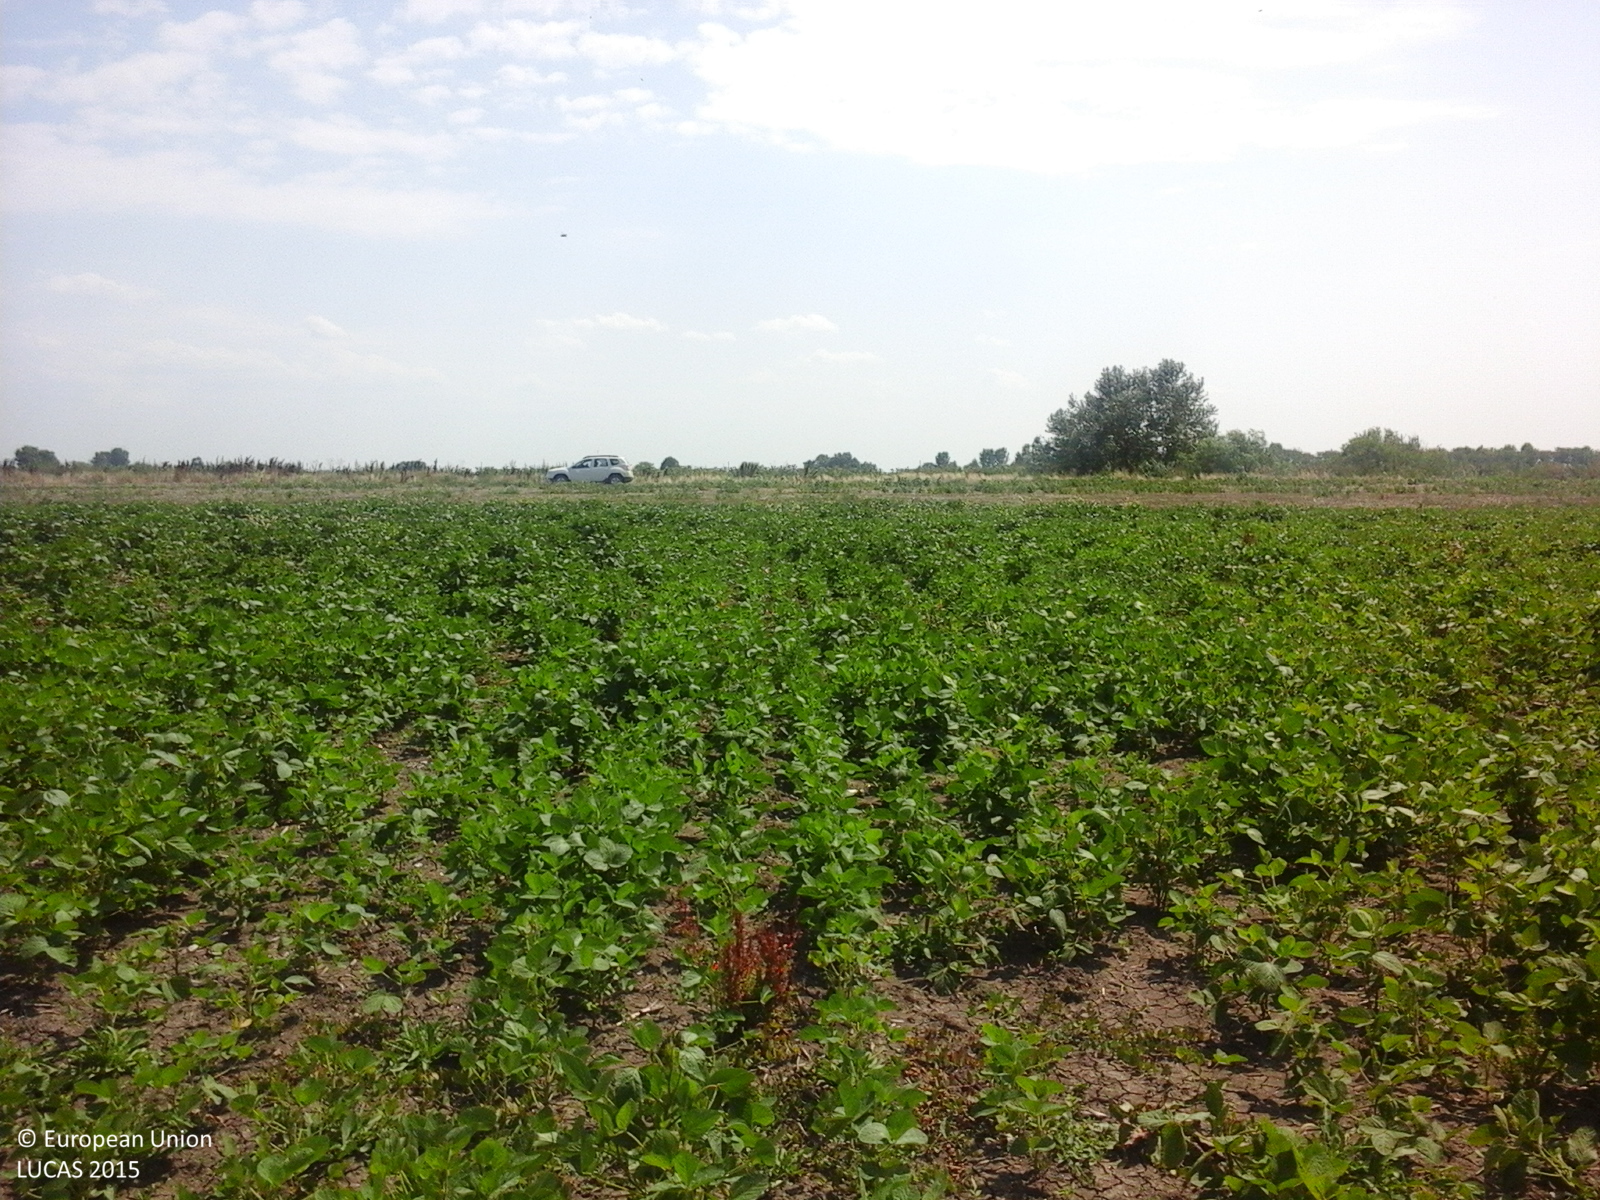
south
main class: Cropland
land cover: Soya
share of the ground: 50 - 75 %
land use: Agriculture (excluding fallow land and kitchen gardens)
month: July
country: RO
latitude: 44.5722
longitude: 27.9764
